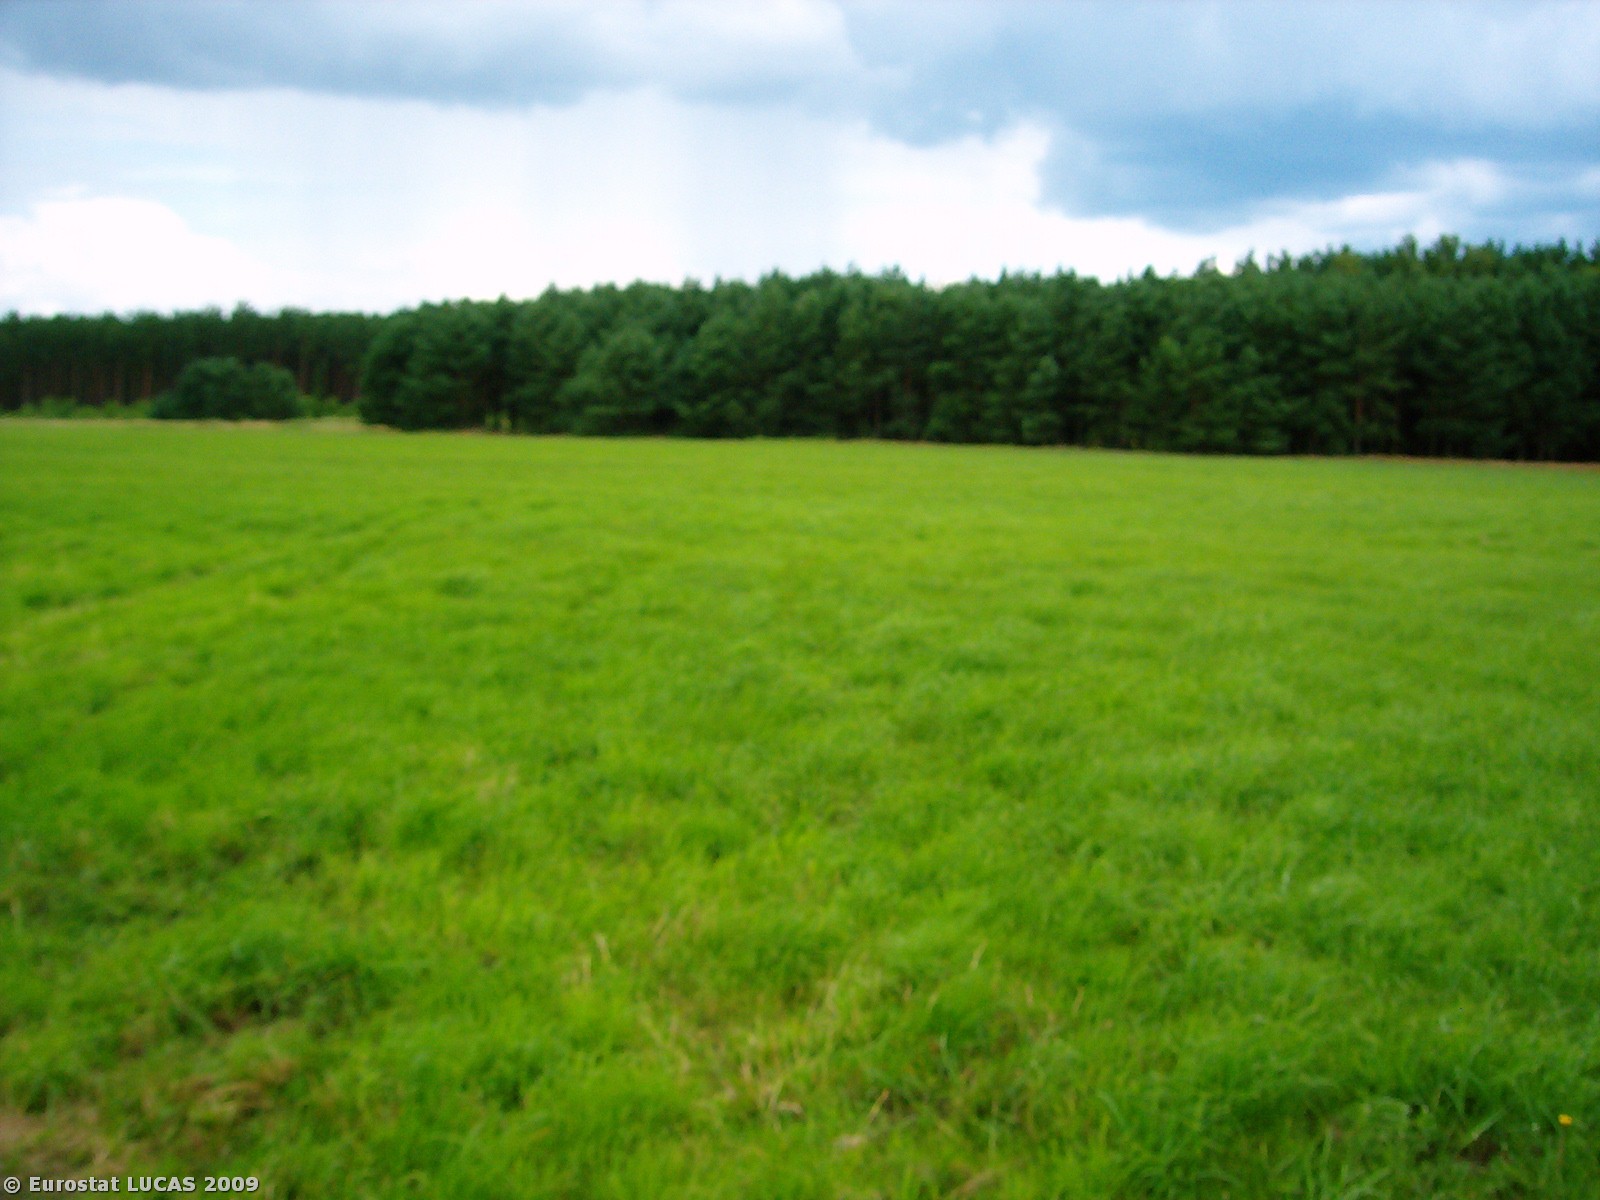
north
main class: Grassland
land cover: Grassland without tree/shrub cover
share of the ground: > 75 %
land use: Agriculture (excluding fallow land and kitchen gardens)
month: July
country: PL
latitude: 52.2942
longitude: 15.7083
